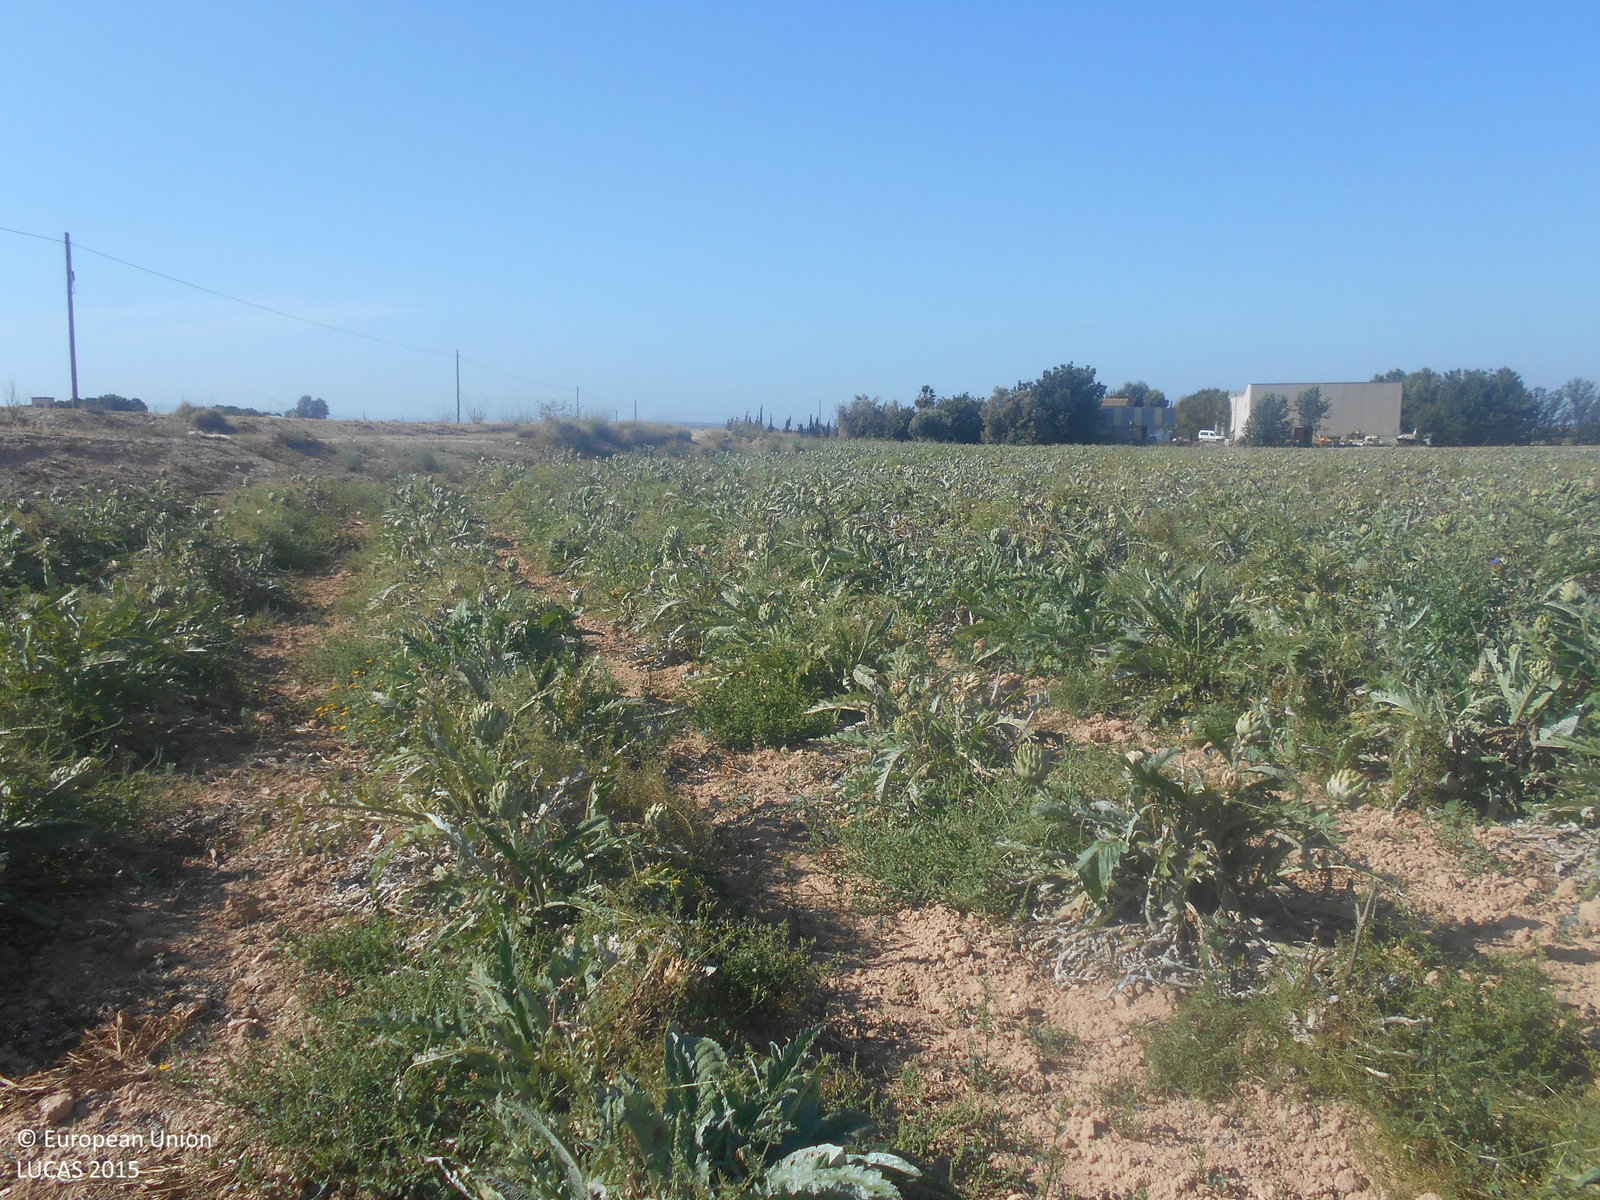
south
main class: Cropland
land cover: Other fresh vegetables
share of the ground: 25 - 50 %
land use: Agriculture (excluding fallow land and kitchen gardens)
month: May
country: ES
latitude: 37.7551
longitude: -0.9332
